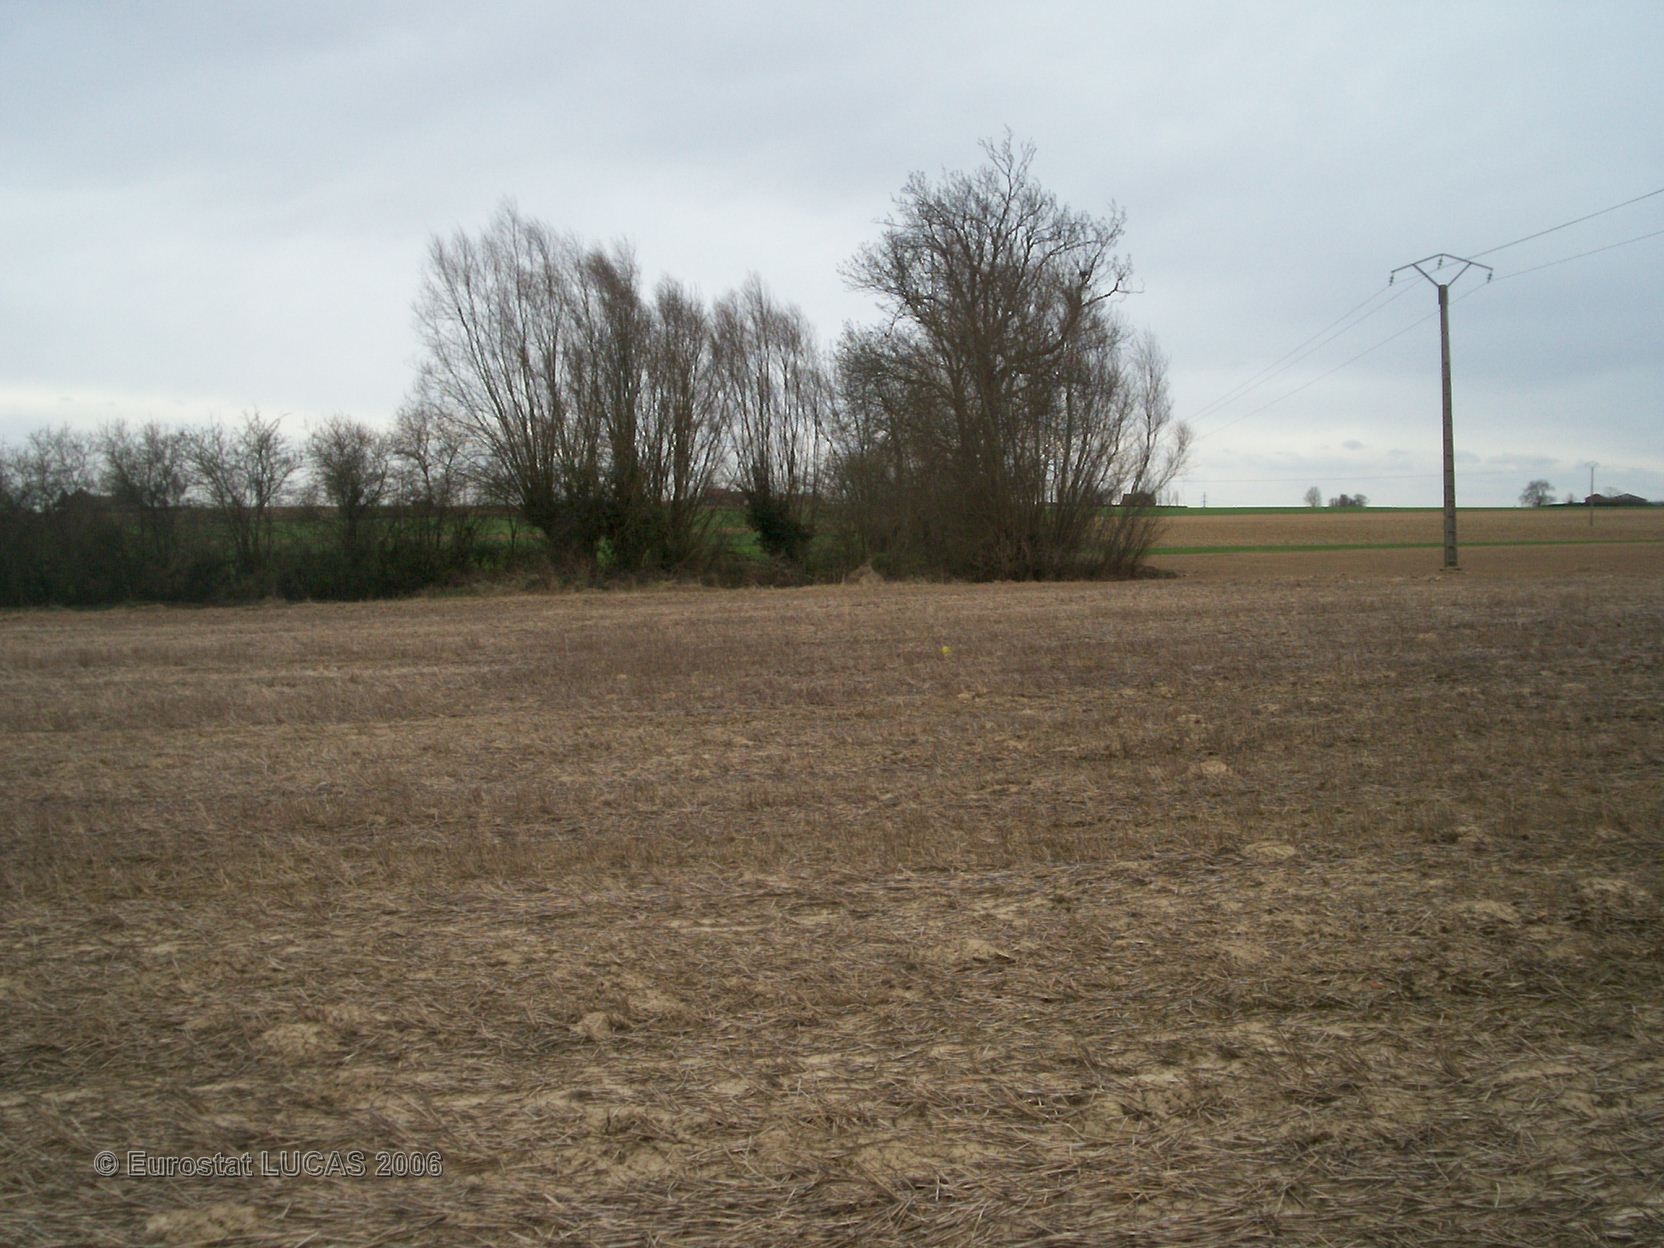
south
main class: Cropland
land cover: Oats
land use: Agriculture (excluding fallow land and kitchen gardens)
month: April
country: FR
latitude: 50.6936
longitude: 2.4700
